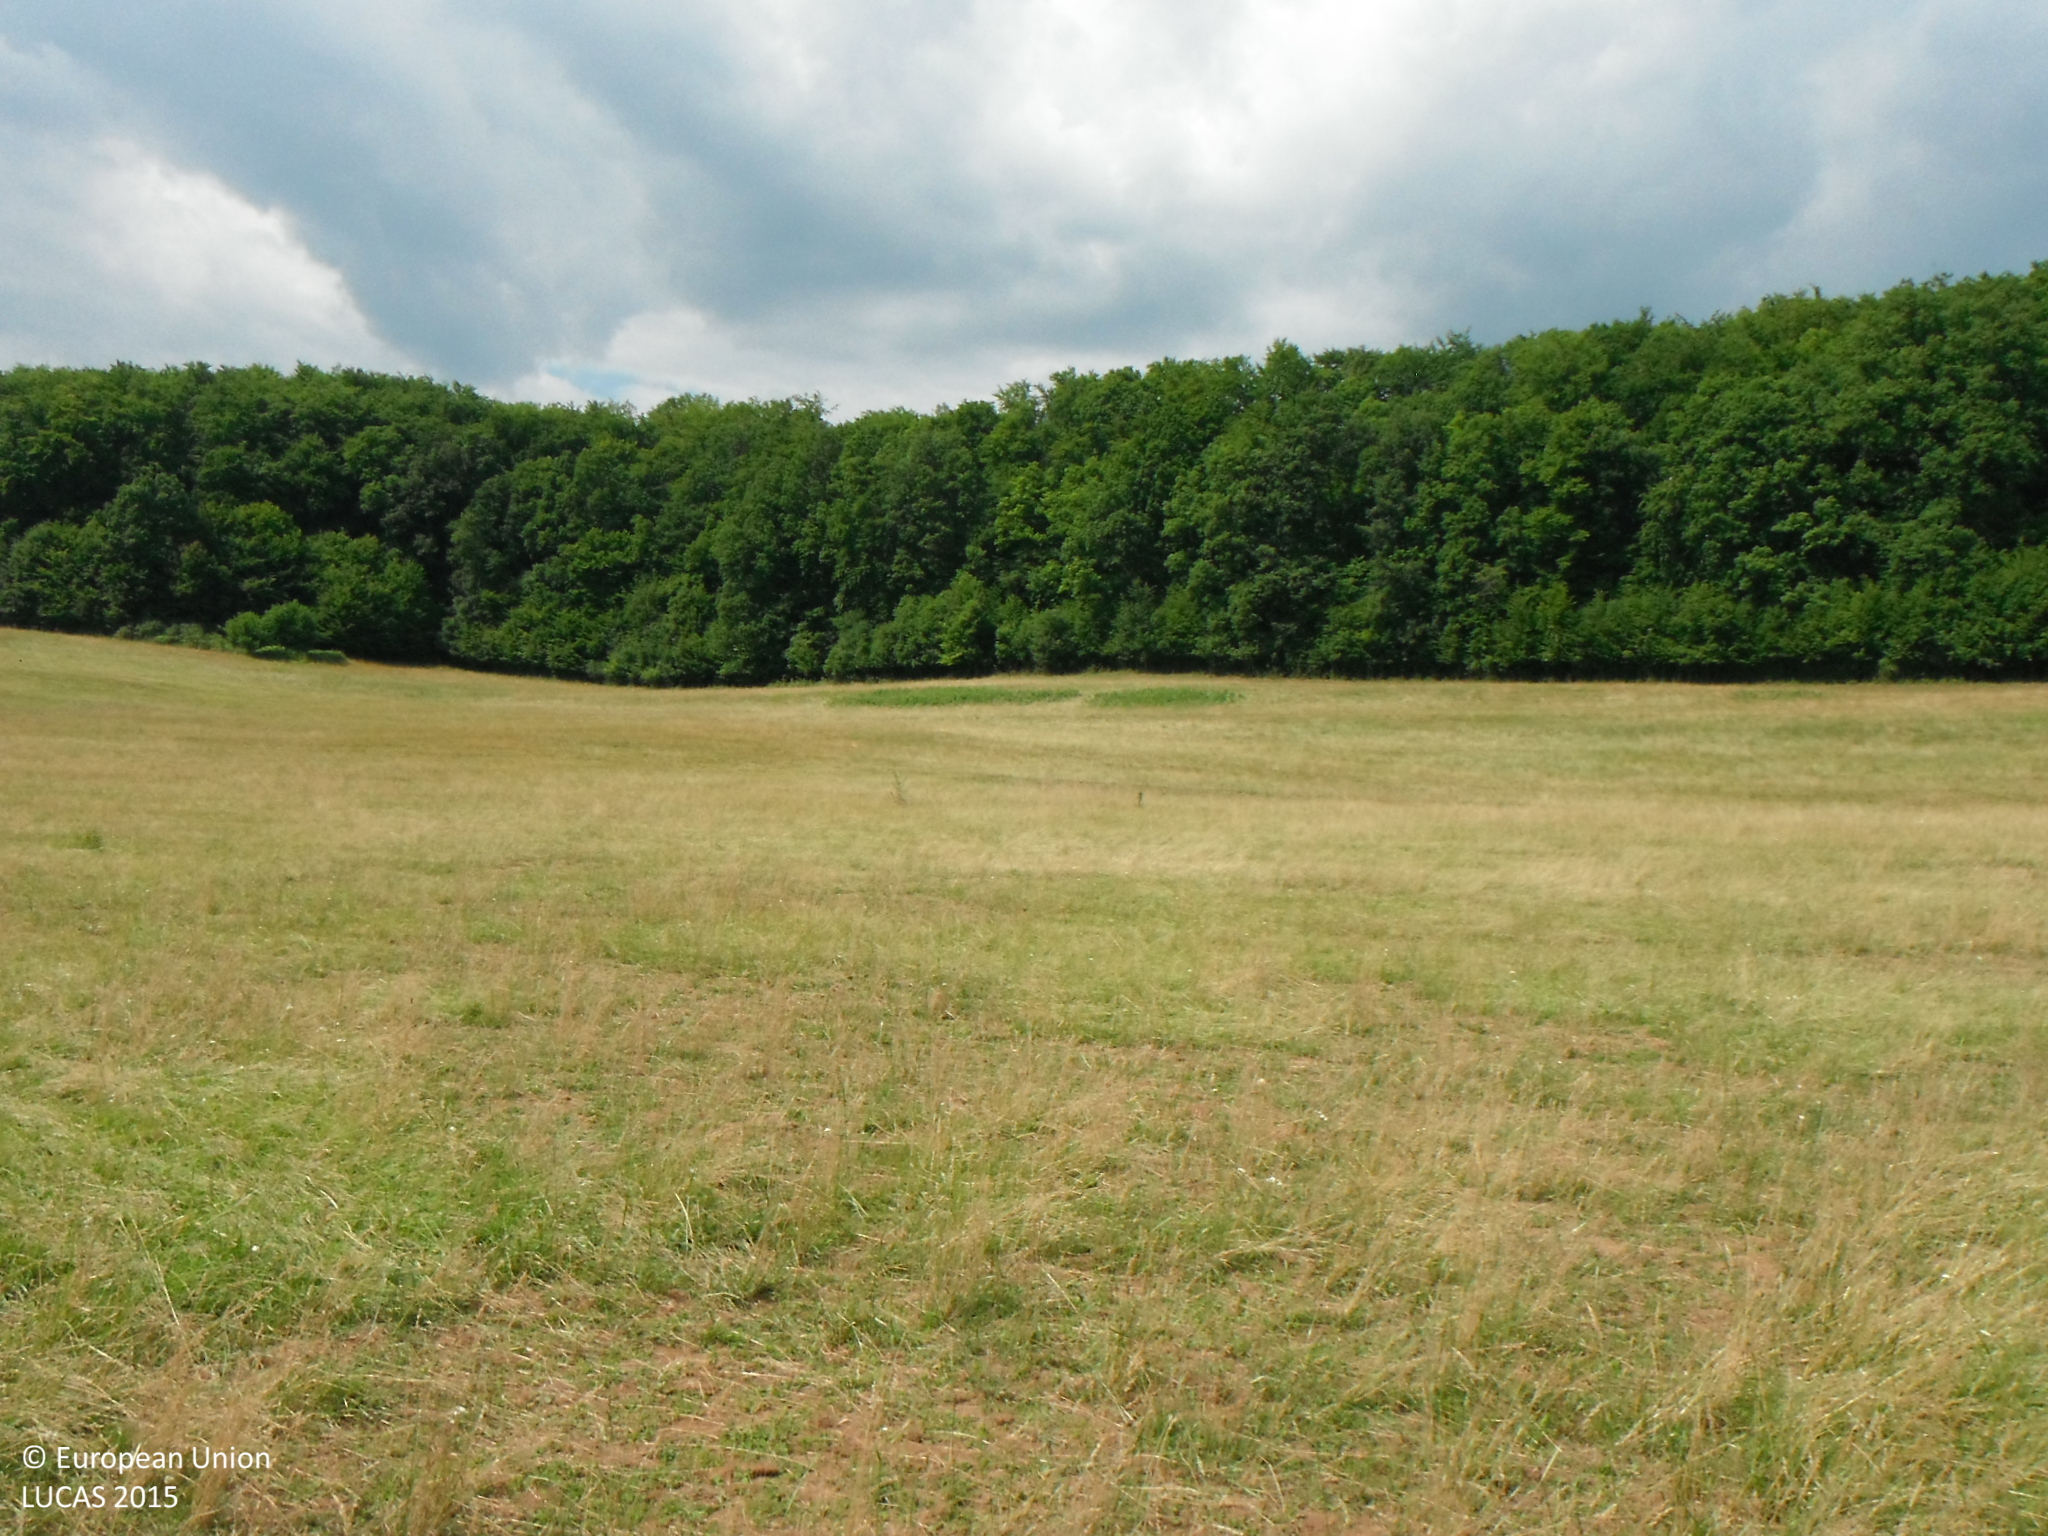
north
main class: Grassland
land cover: Grassland without tree/shrub cover
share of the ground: > 75 %
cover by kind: herbaceous plants 100 %
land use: Agriculture (excluding fallow land and kitchen gardens)
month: June
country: SK
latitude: 48.5210
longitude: 20.0902
